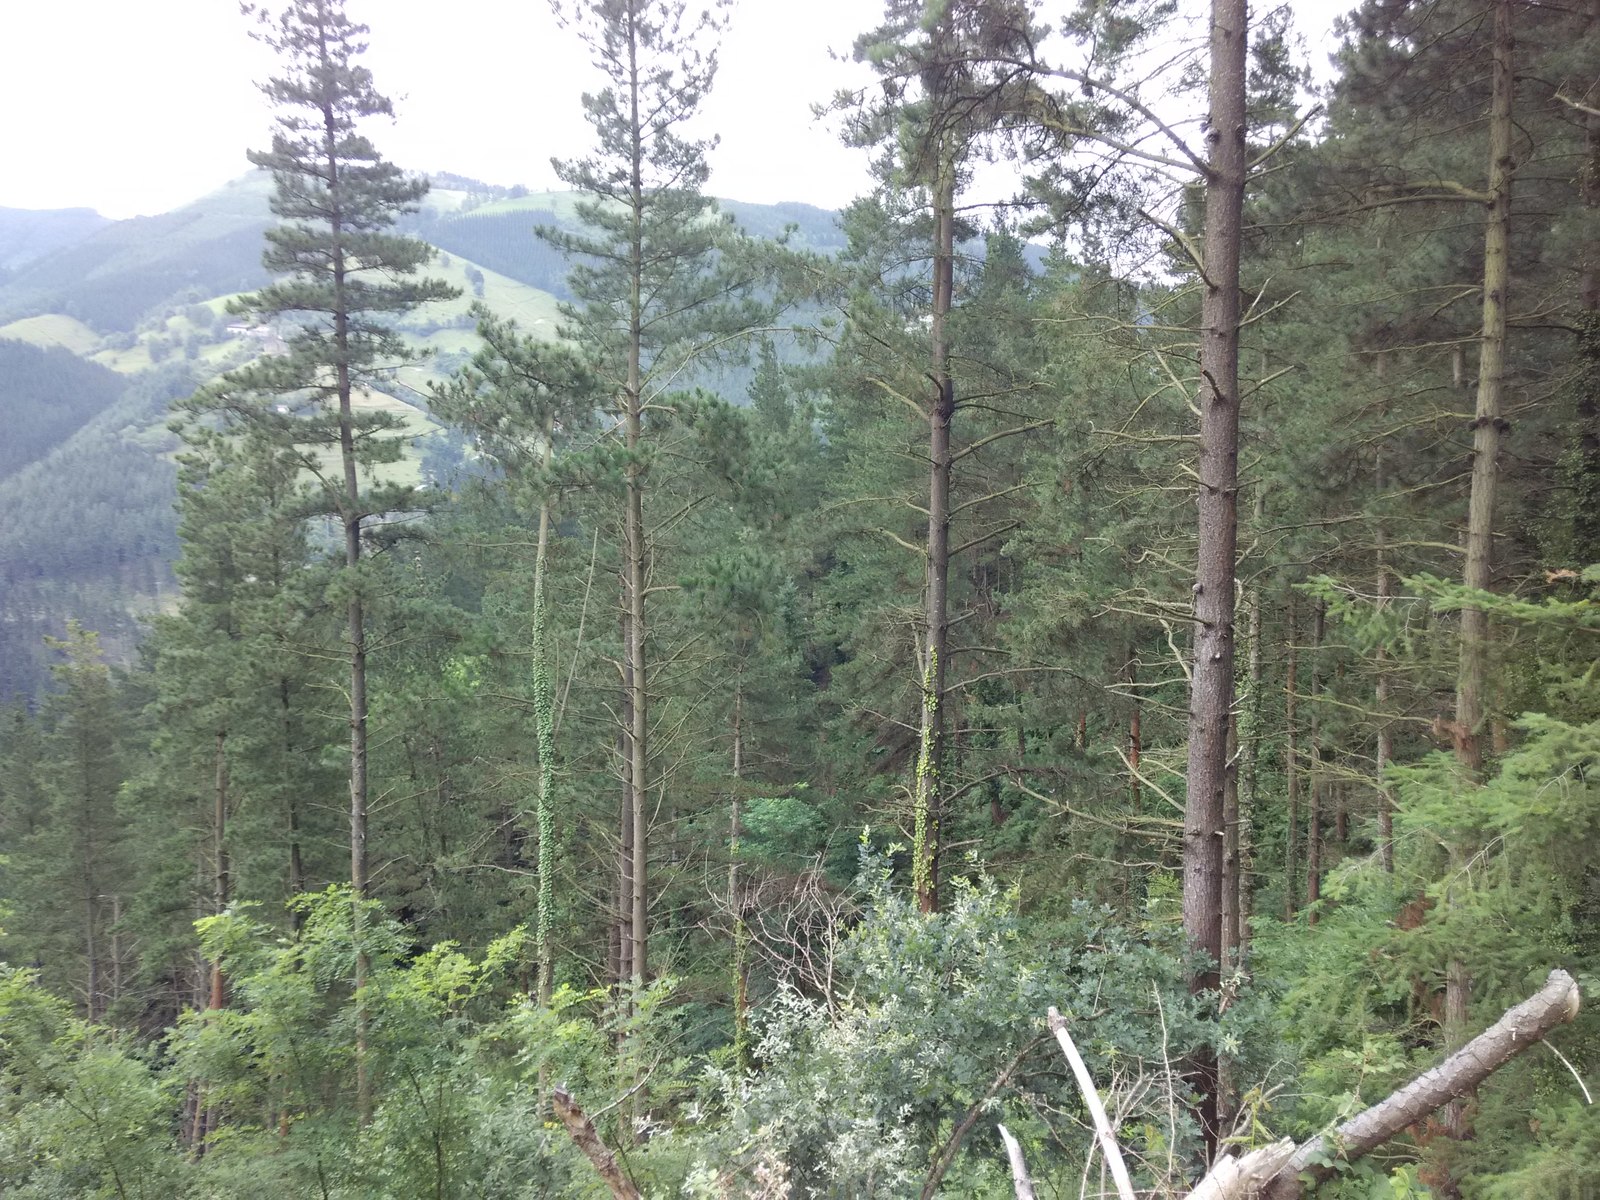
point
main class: Woodland
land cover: Pine dominated coniferous woodland
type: exotic forest
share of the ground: > 75 %
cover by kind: coniferous forest trees 100 %
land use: Forestry
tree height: > 5 m
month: July
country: ES
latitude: 43.0875
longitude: -2.4454
